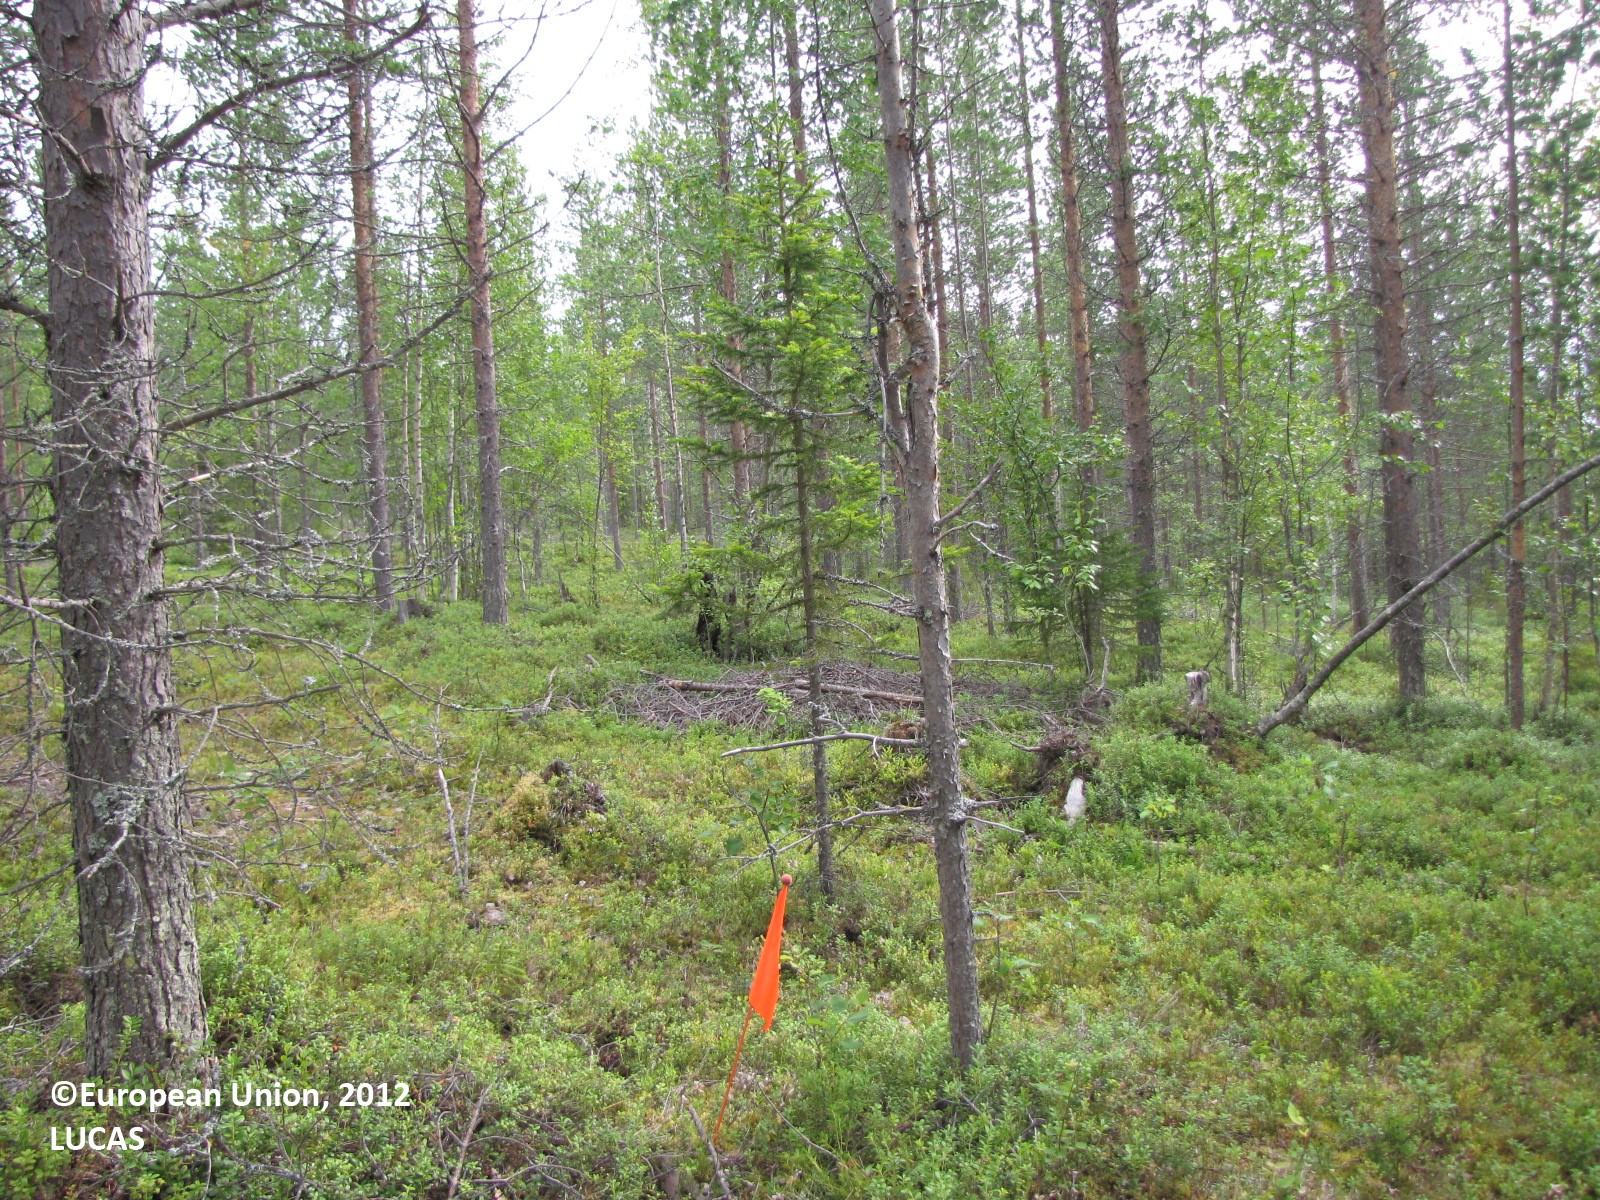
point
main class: Woodland
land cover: Pine dominated mixed woodland
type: boreal forest
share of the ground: 25 - 50 %
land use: Forestry
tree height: > 5 m
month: August
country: FI
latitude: 66.8645
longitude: 24.9411
